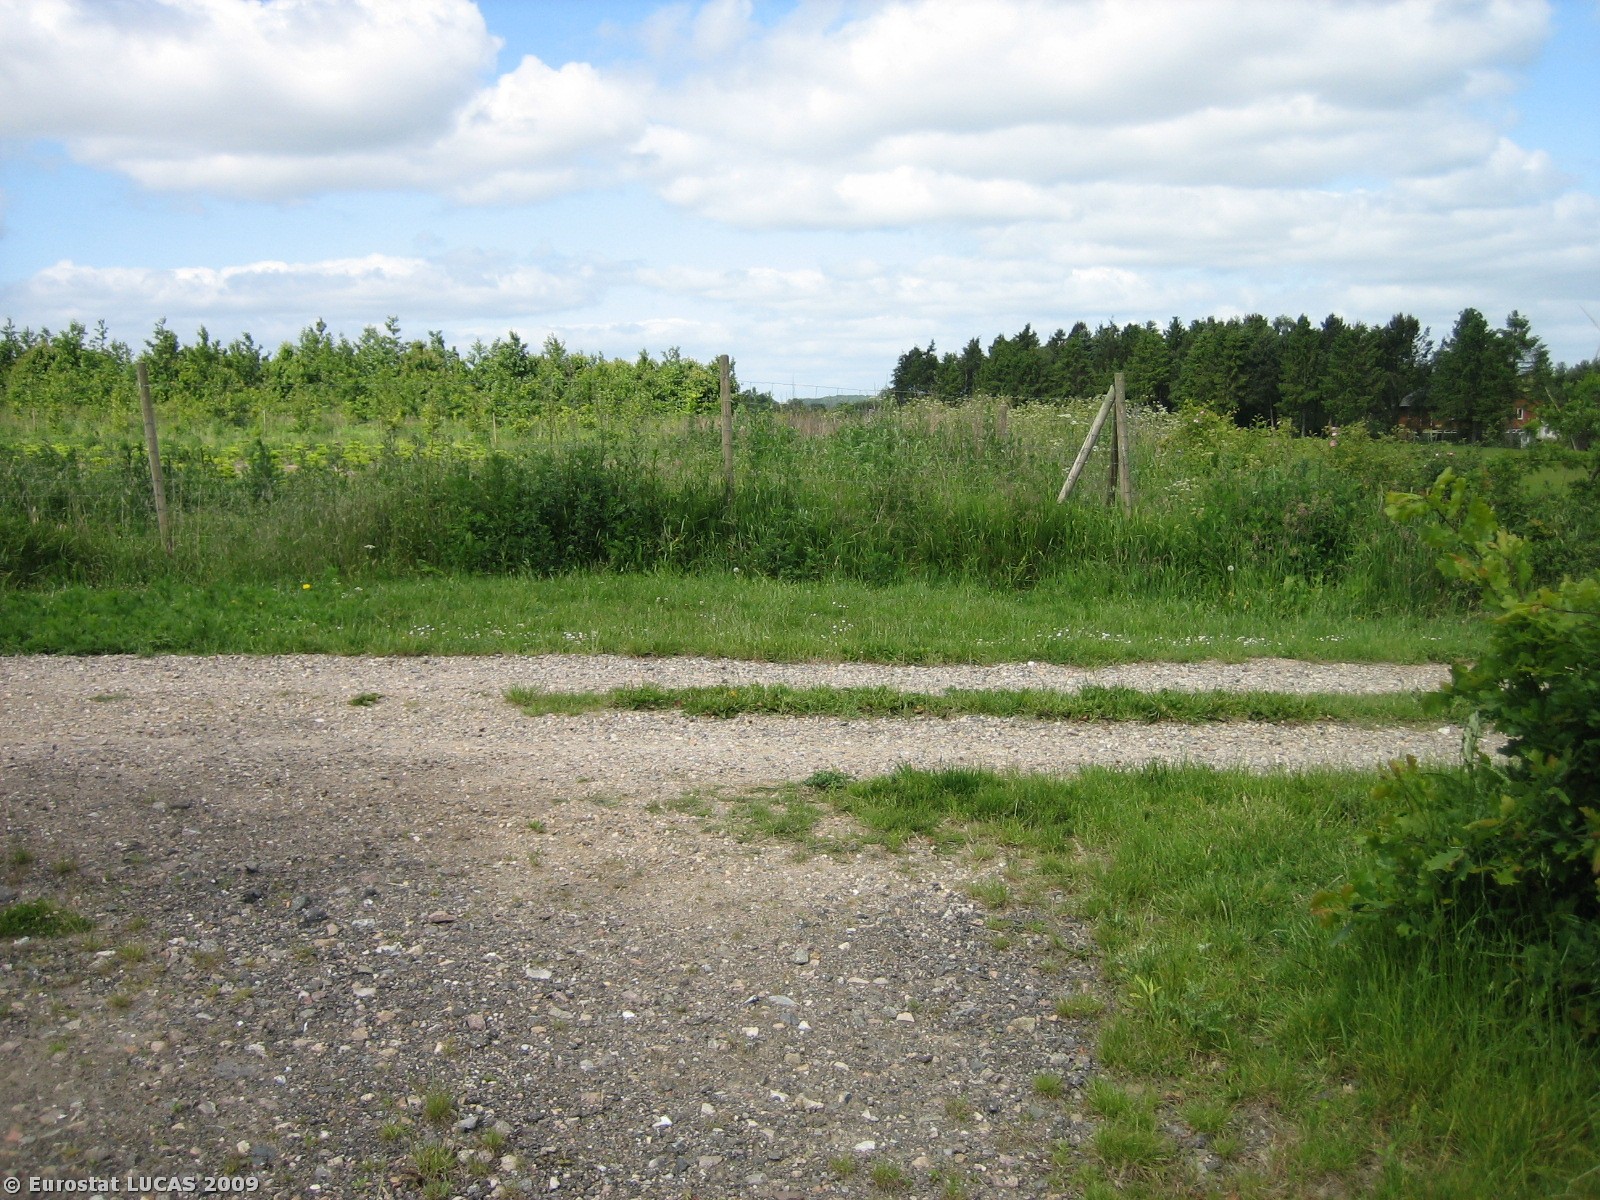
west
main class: Woodland
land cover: Coniferous woodland
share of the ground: 10 - 25 %
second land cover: Bare land
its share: > 75 %
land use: Agriculture (excluding fallow land and kitchen gardens)
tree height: < 5 m
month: June
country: DK
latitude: 55.8638
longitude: 9.6967
